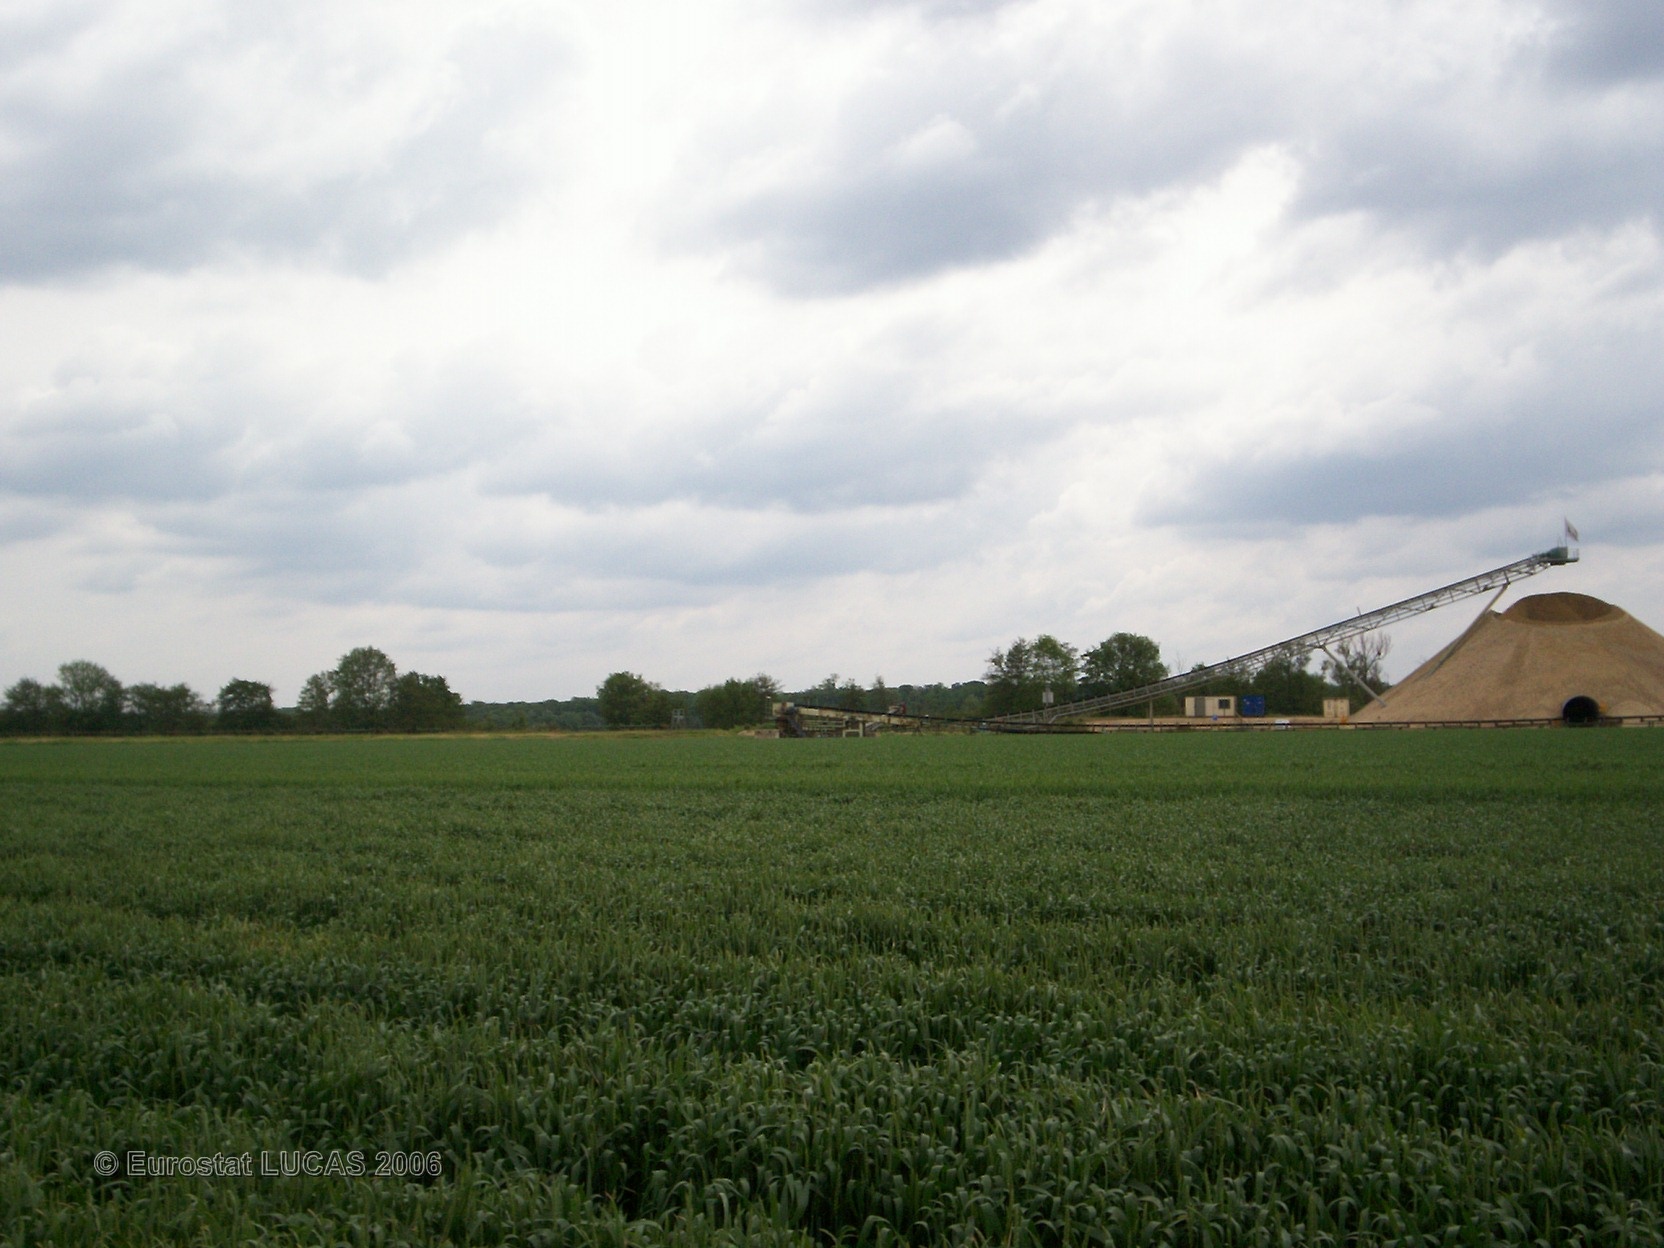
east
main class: Cropland
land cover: Common wheat
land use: Agriculture (excluding fallow land and kitchen gardens)
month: June
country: FR
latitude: 49.3385
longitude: 2.7365
